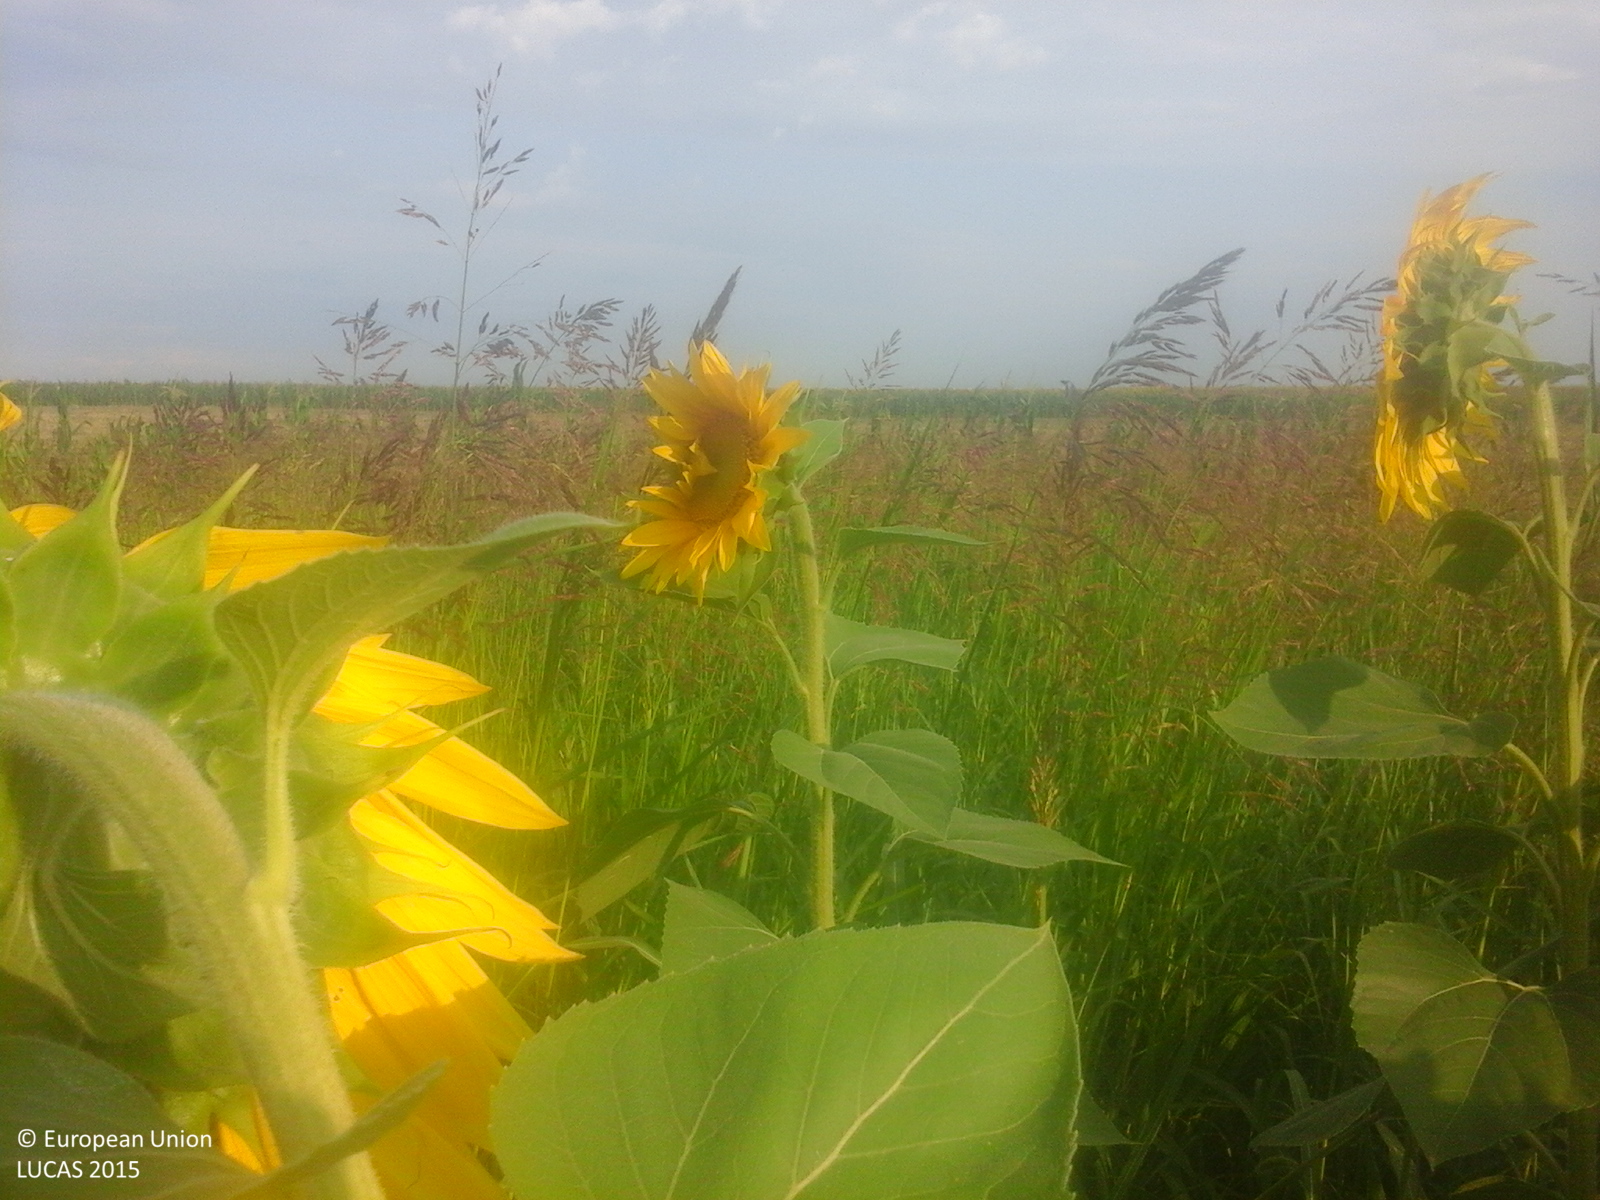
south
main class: Cropland
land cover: Sunflower
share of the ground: > 75 %
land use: Agriculture (excluding fallow land and kitchen gardens)
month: July
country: RO
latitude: 43.8625
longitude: 24.5868
